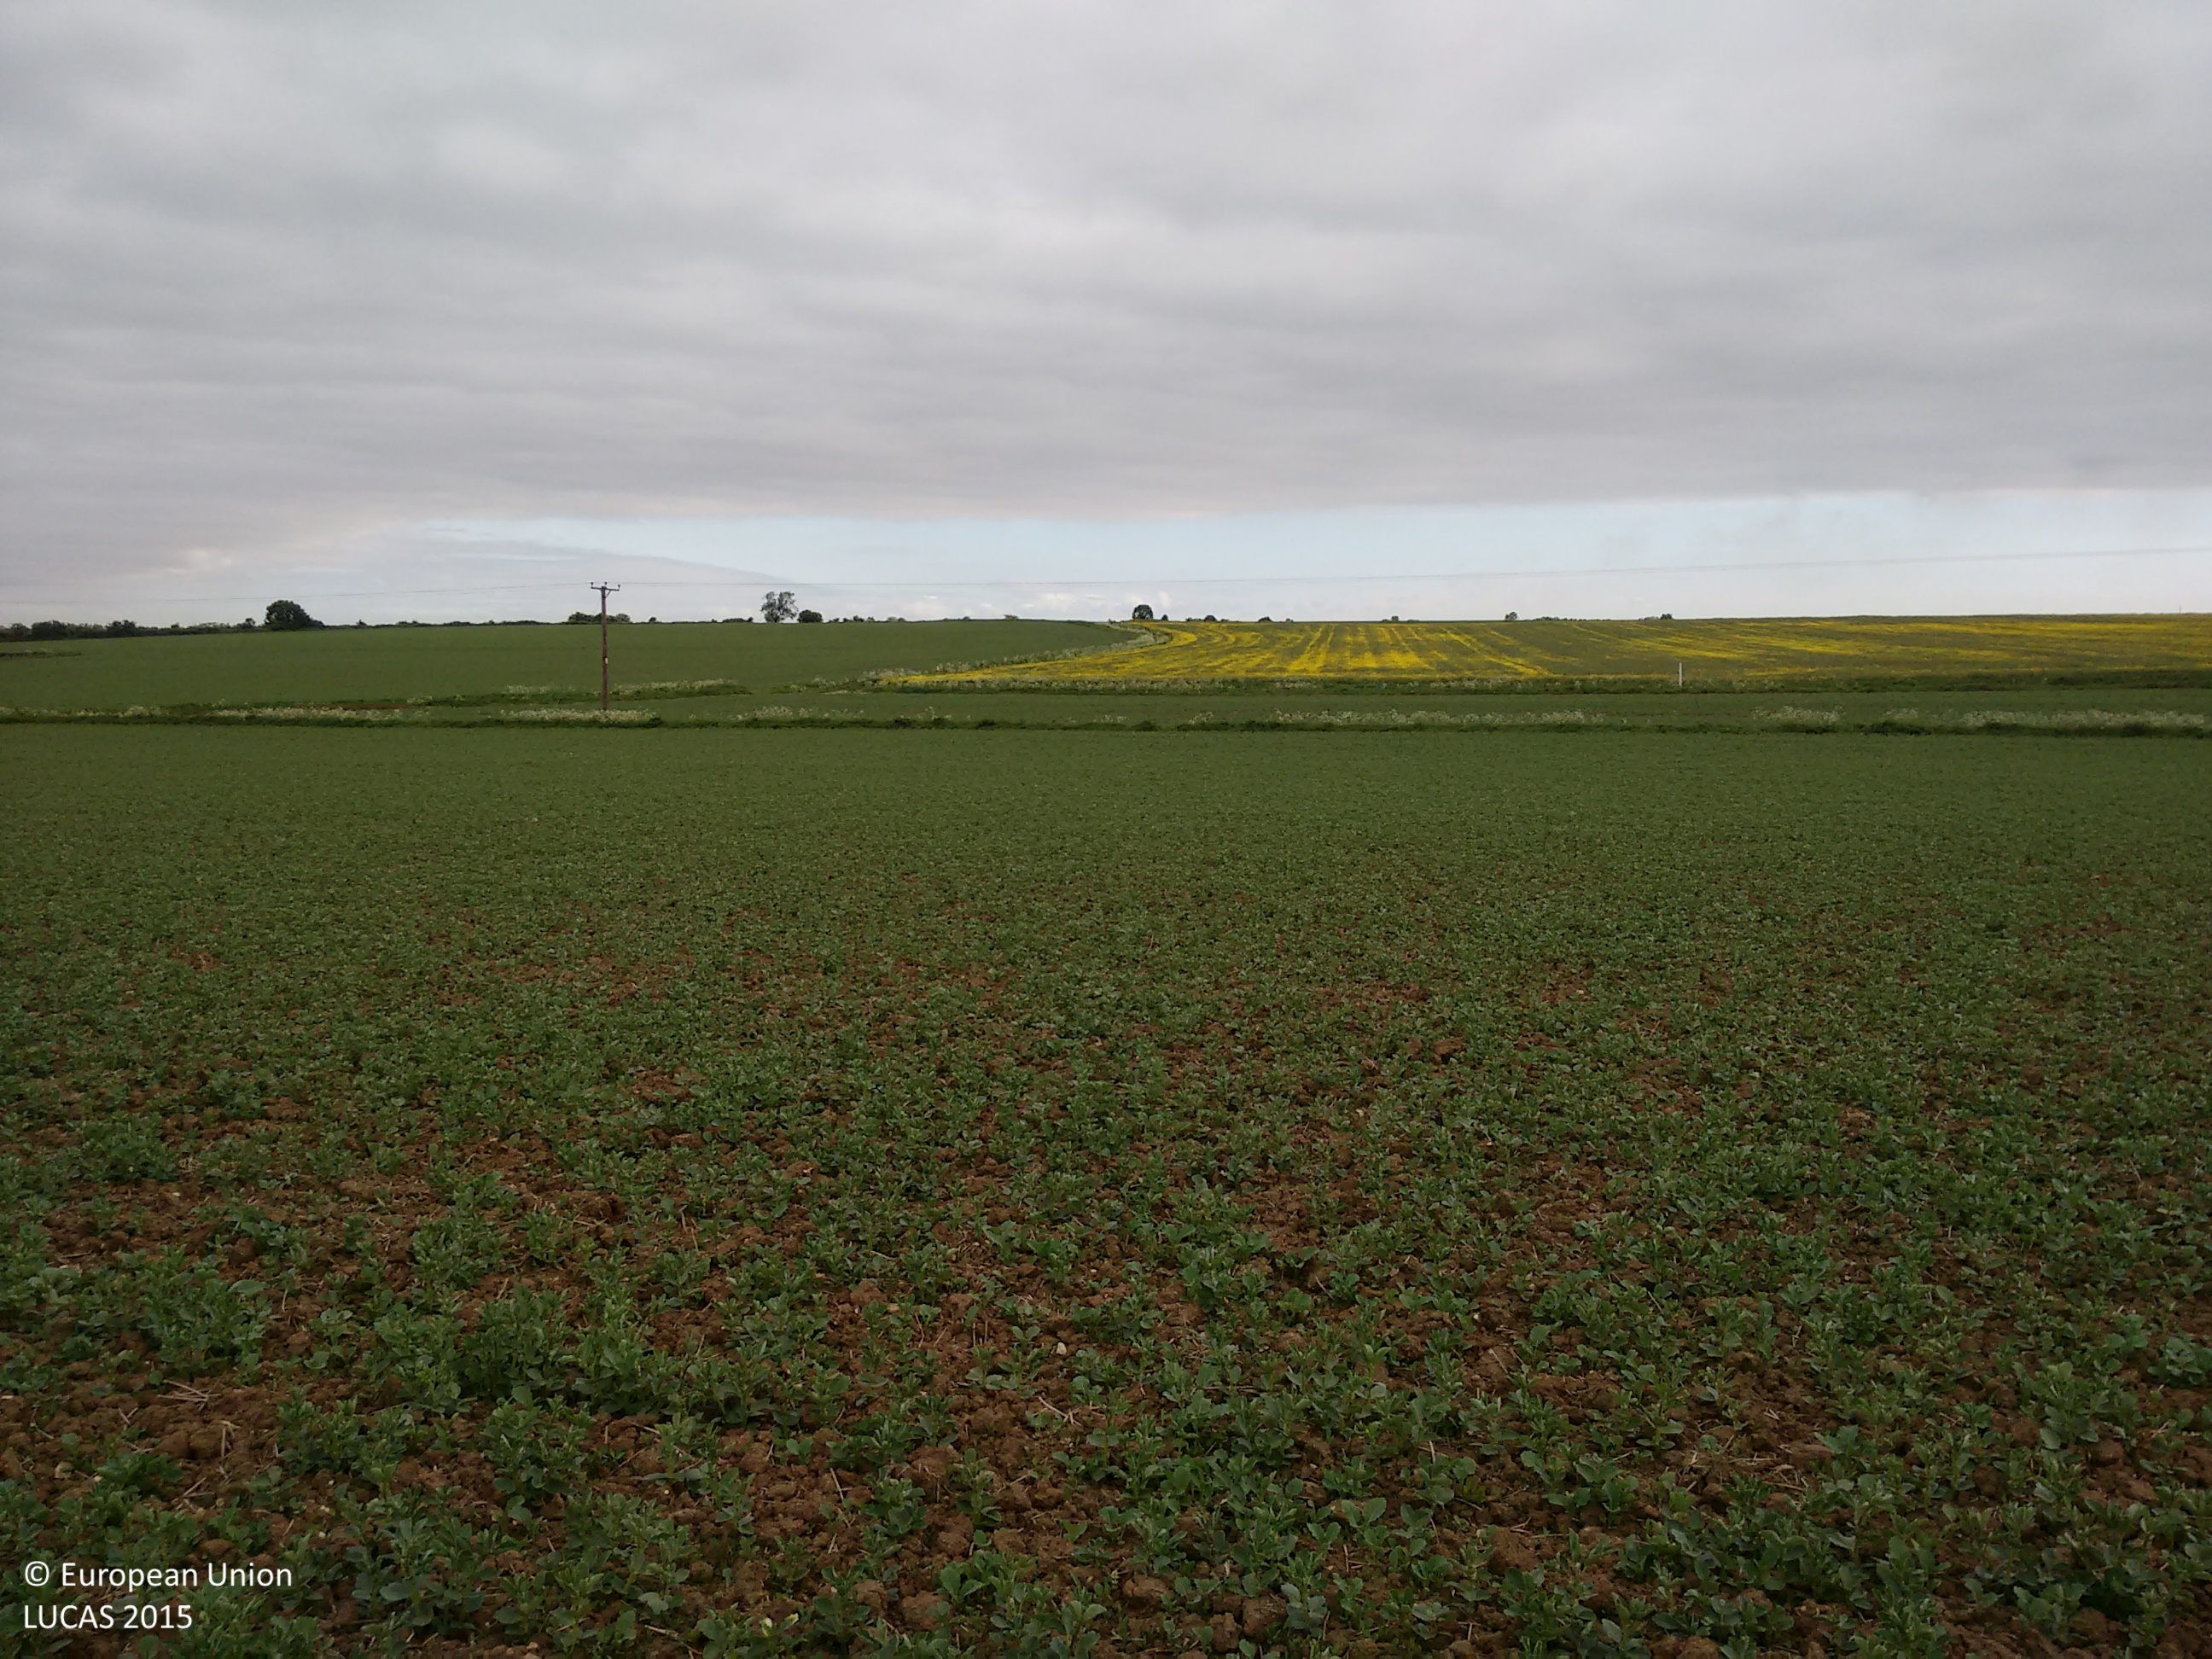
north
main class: Cropland
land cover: Dry pulses
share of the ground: 50 - 75 %
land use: Agriculture (excluding fallow land and kitchen gardens)
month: May
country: GB
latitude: 53.4590
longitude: -0.6266
